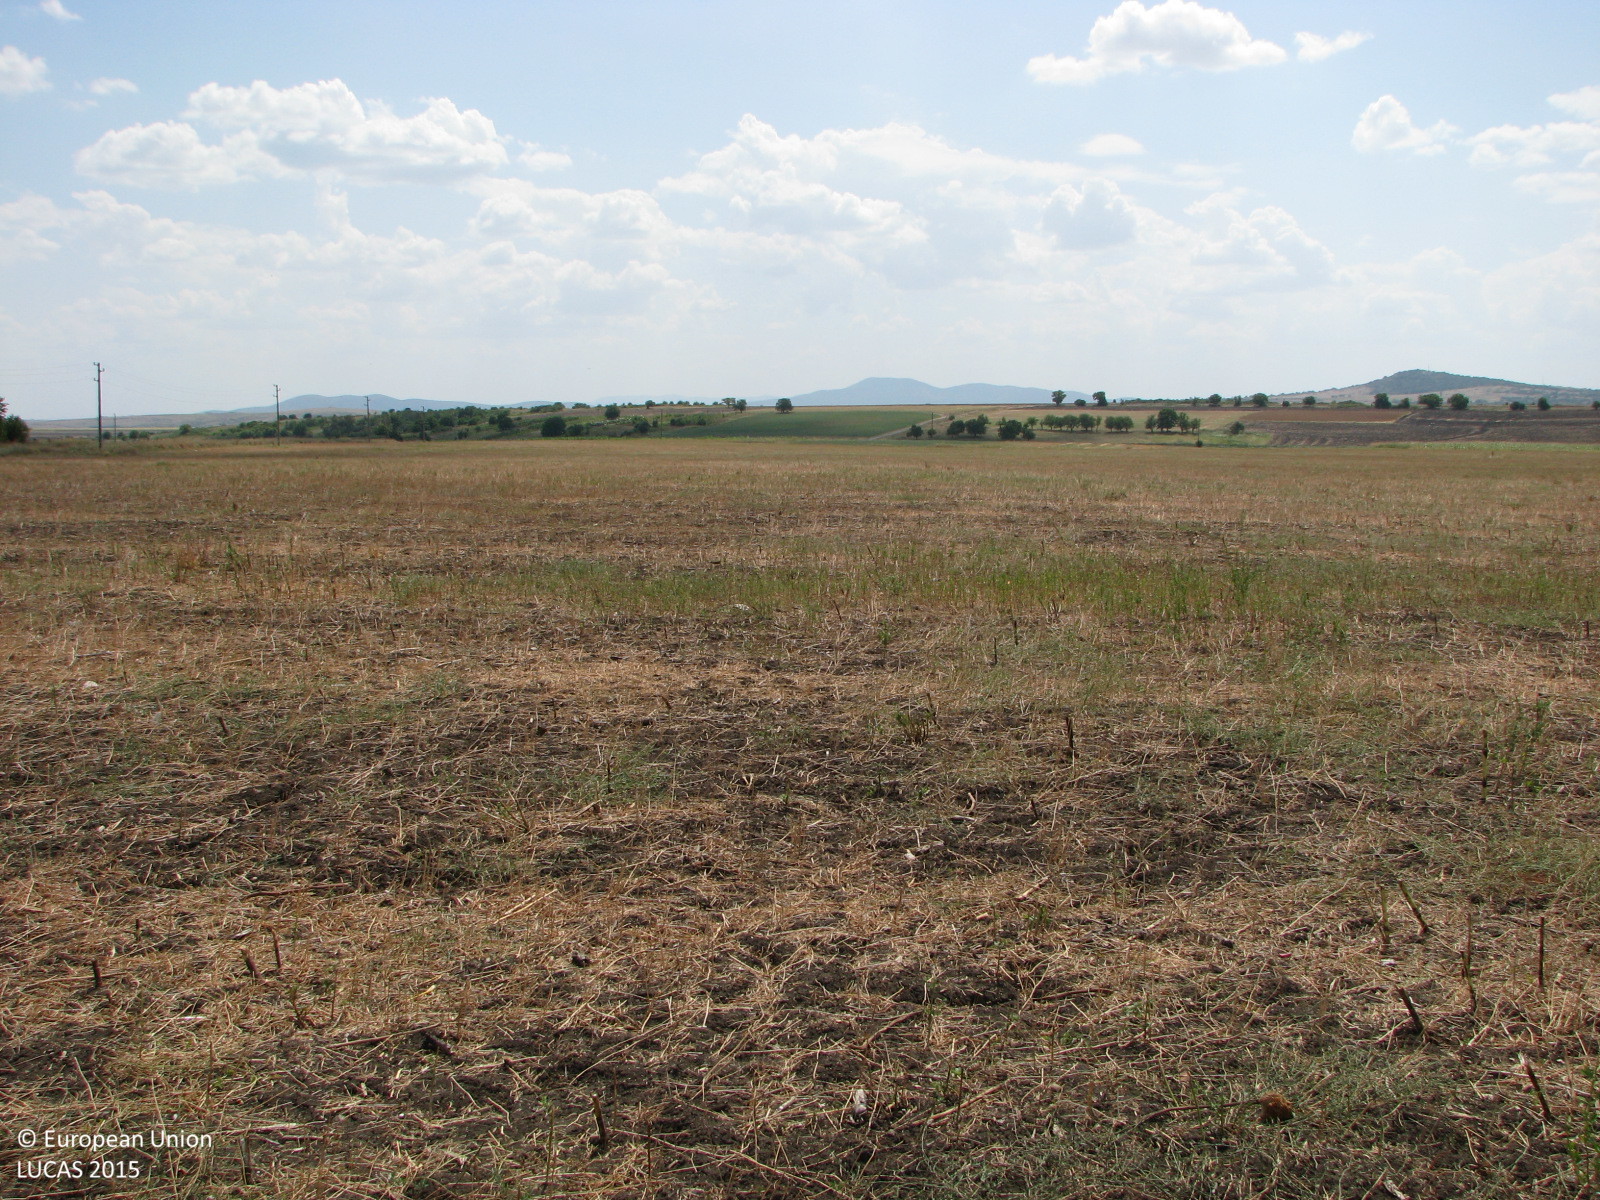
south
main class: Cropland
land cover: Other non-permanent industrial crops
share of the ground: < 10 %
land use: Agriculture (excluding fallow land and kitchen gardens)
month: August
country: BG
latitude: 42.3911
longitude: 26.4027
